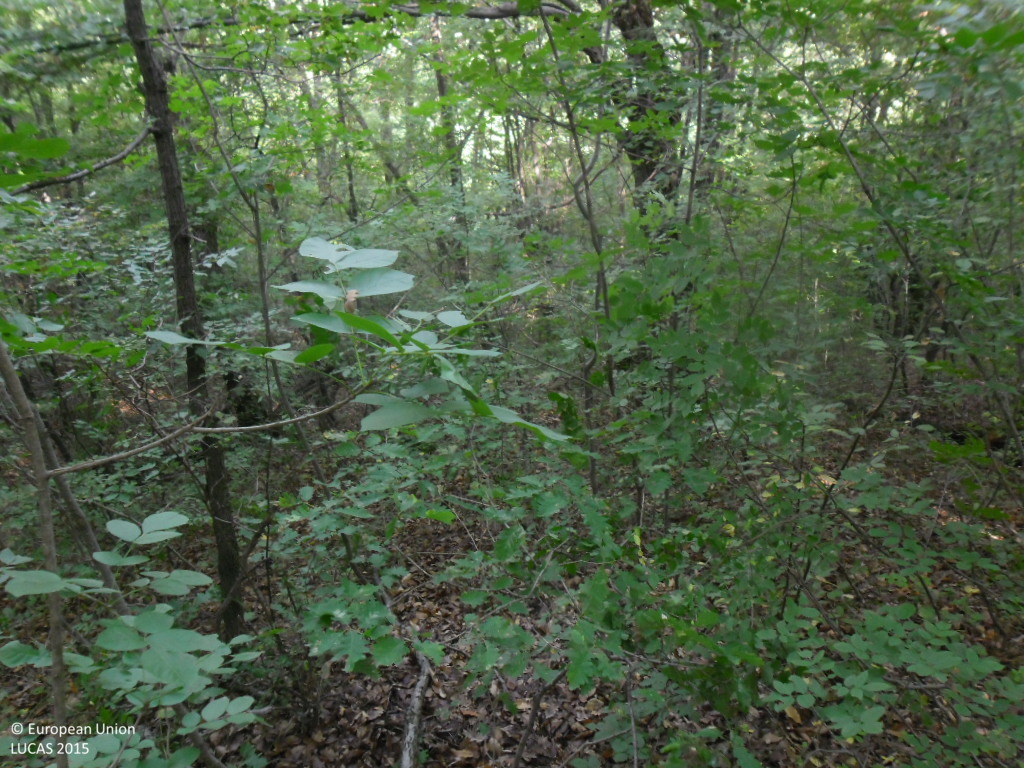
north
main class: Woodland
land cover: Broadleaved woodland
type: mountainous beech forest
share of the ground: > 75 %
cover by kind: broadleaved forest trees 95 %, unconsolidated bare surface 5 %
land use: Forestry
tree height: > 5 m
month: September
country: BG
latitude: 41.8675
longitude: 22.9969
